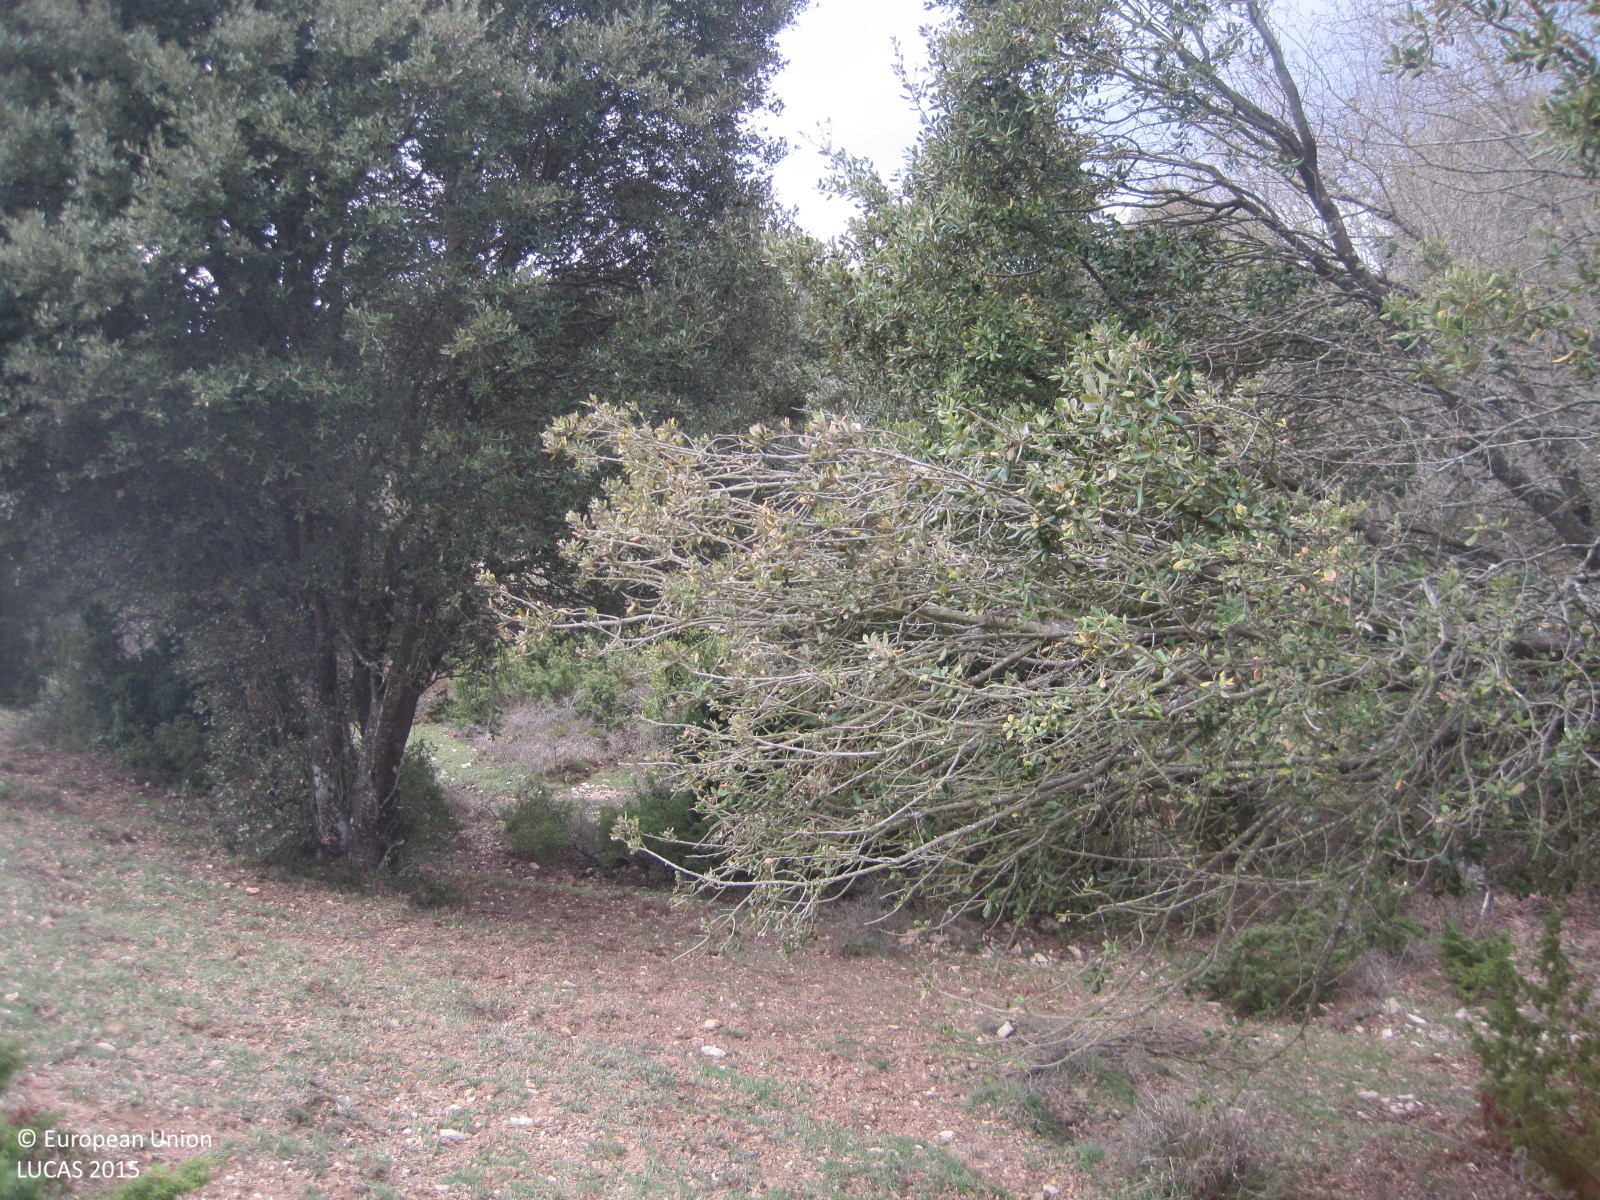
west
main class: Woodland
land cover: Broadleaved woodland
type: broadleaved evergreen forest
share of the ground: 50 - 75 %
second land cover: Grassland without tree/shrub cover
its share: > 75 %
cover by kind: broadleaved forest trees 50 %, herbaceous plants 45 %, shrubs 5 %
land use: Forestry
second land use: Agriculture (excluding fallow land and kitchen gardens)
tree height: > 5 m
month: April
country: ES
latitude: 42.7169
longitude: -2.1940
